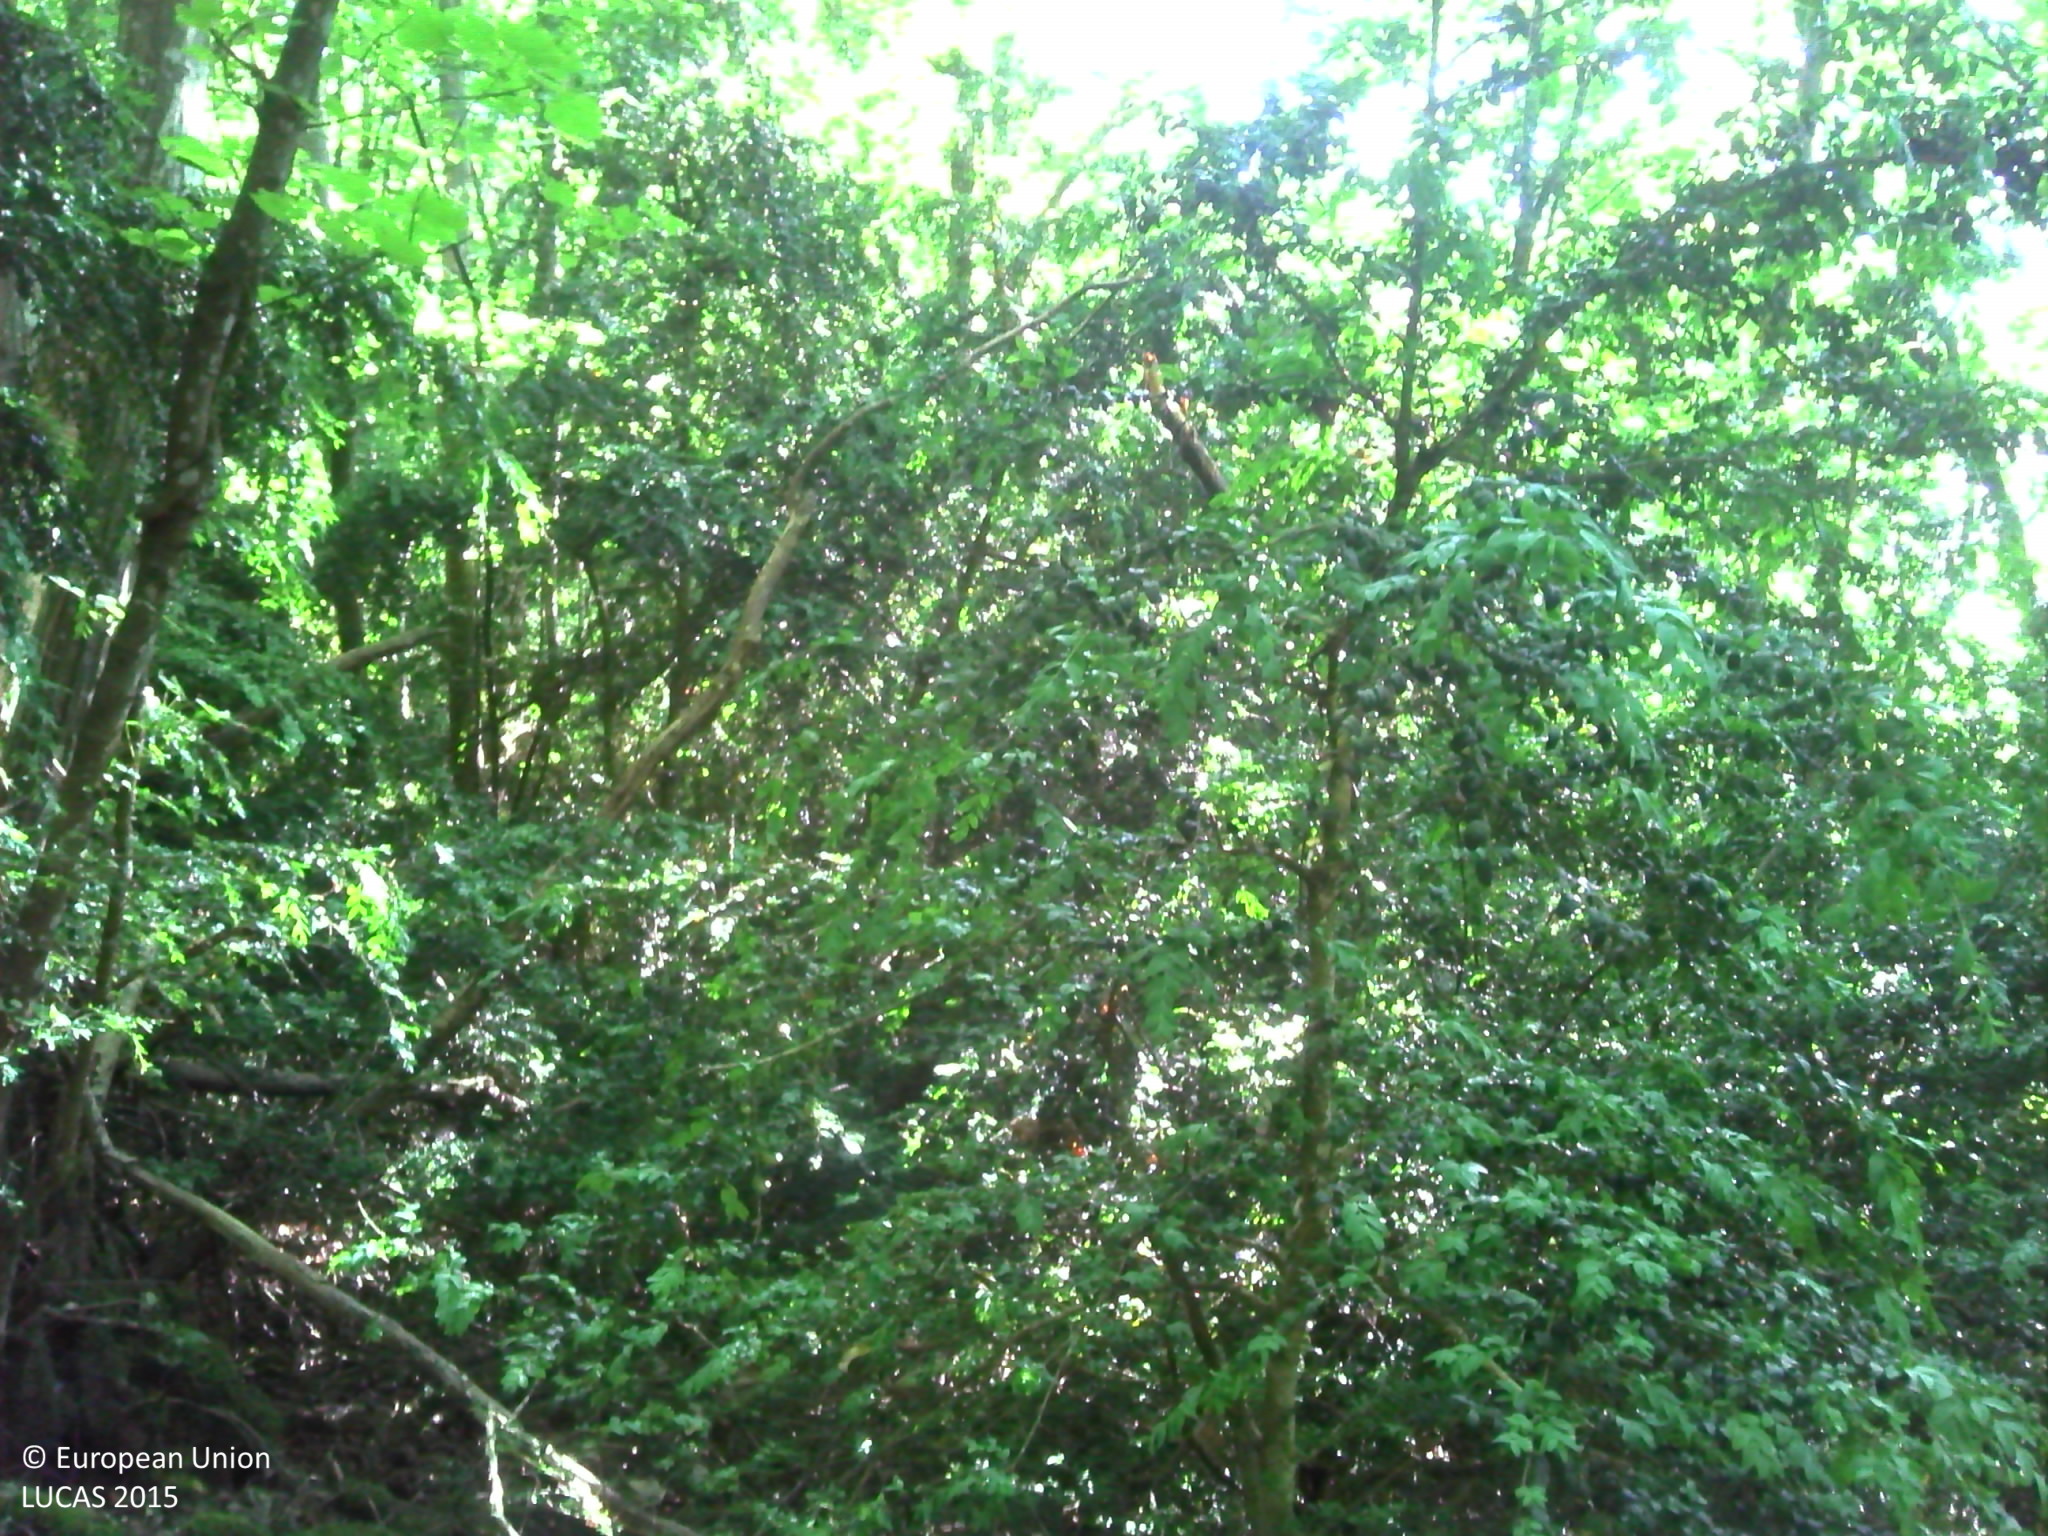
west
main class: Woodland
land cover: Broadleaved woodland
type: acidophilous oak and oak-birch forest
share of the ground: > 75 %
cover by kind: broadleaved forest trees 80 %, herbaceous plants 10 %, lichens and mosses 10 %
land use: Forestry
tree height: > 5 m
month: June
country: FR
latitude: 46.6046
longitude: 4.8187
